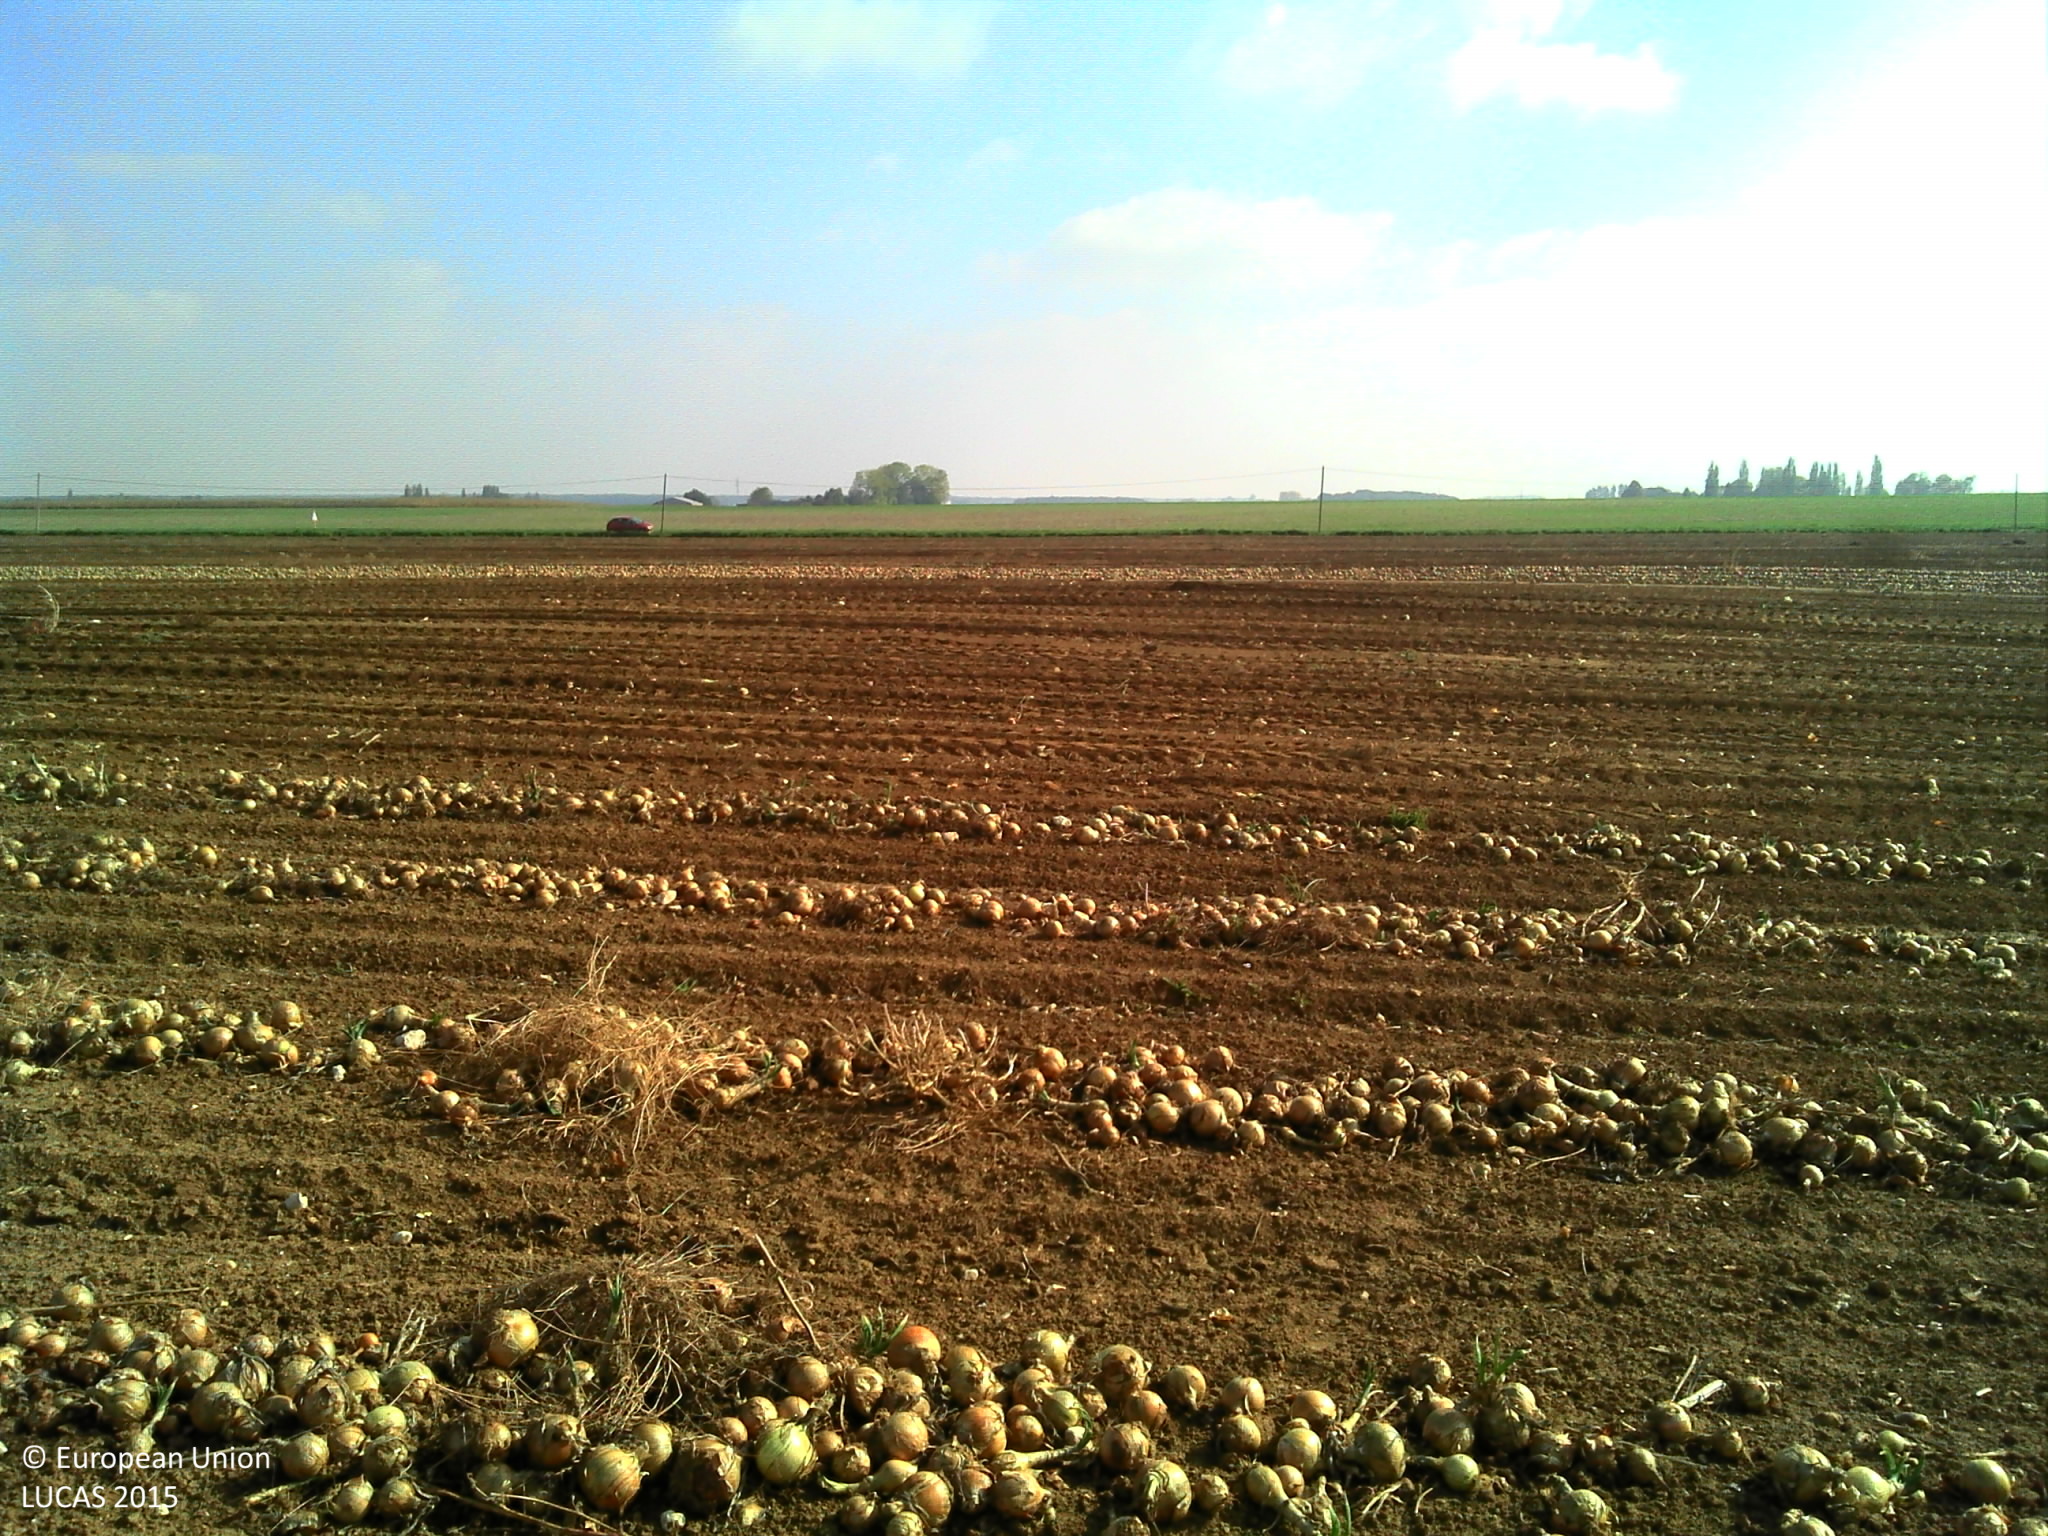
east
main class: Cropland
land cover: Other root crops
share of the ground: 25 - 50 %
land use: Agriculture (excluding fallow land and kitchen gardens)
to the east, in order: Other root crops; Electric lines; Ditches and canals; Grass margins; Paved roads, cycling and walking lanes; Grass margins; Ditches and canals; Common wheat
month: October
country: FR
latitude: 47.8123
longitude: 1.3706
